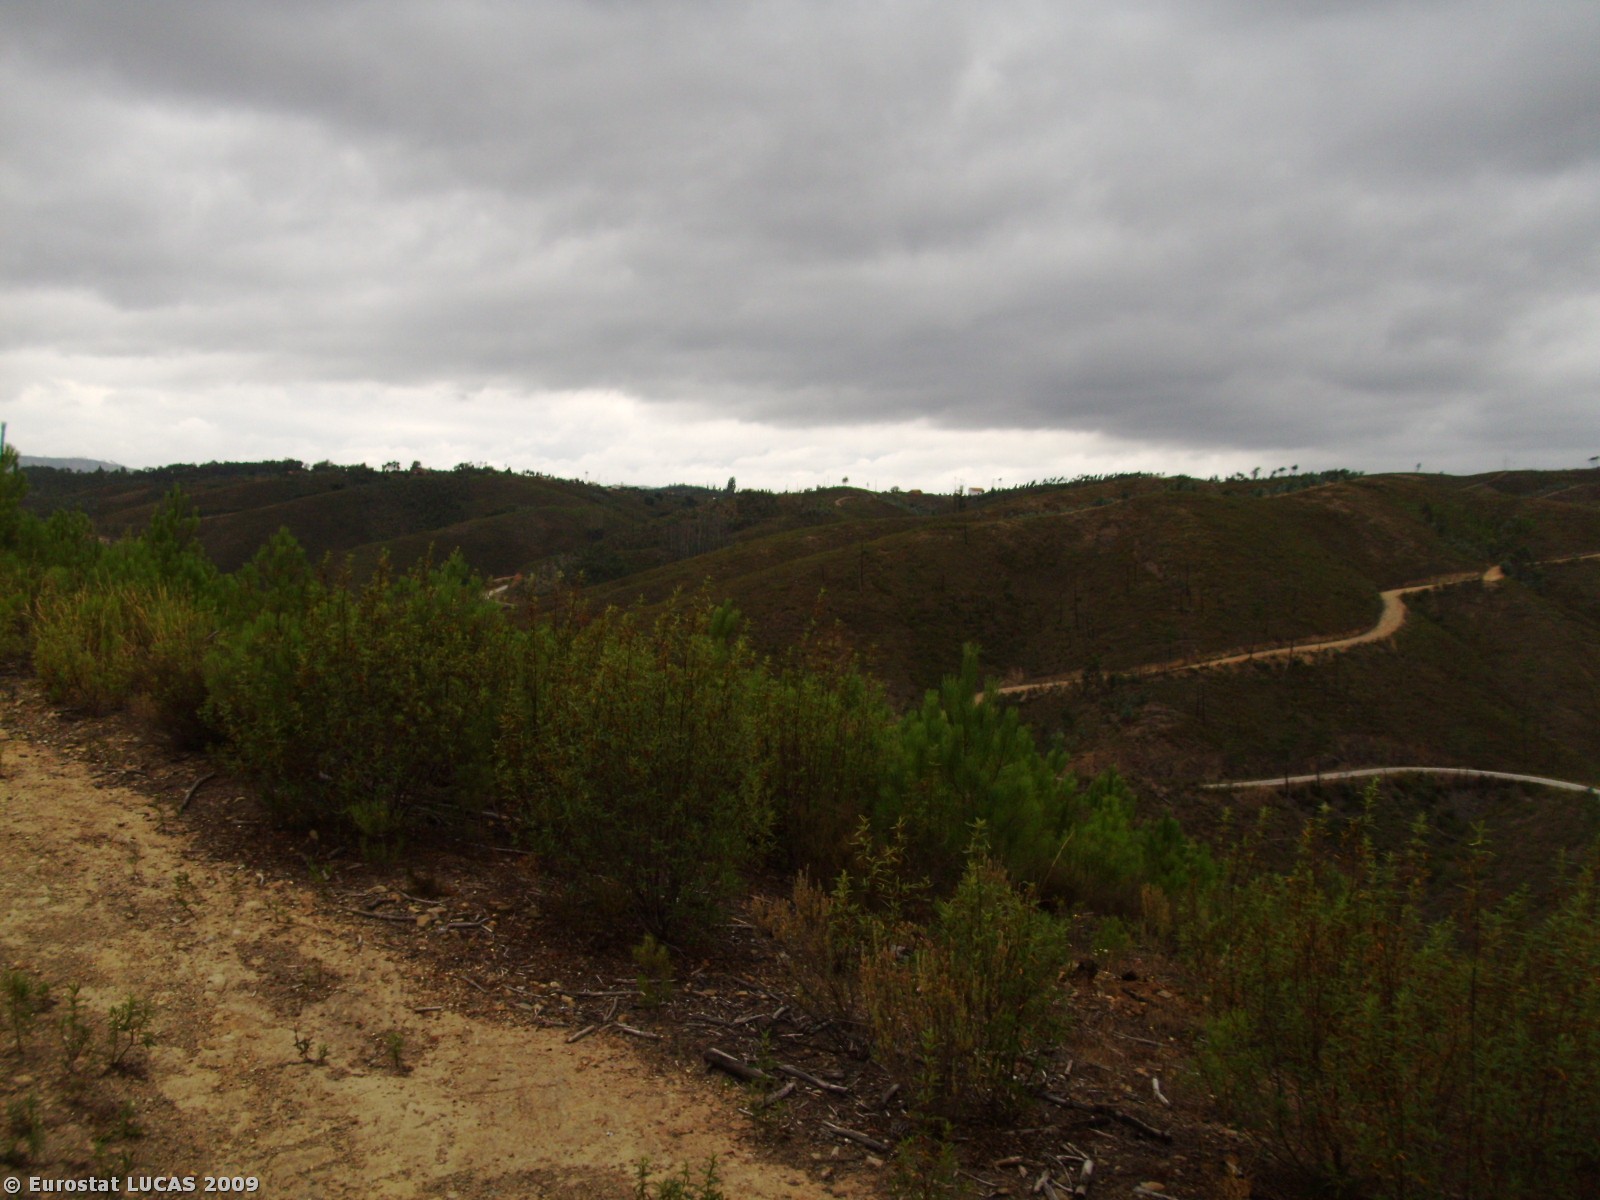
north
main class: Woodland
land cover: Coniferous woodland
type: coniferous forest of the mediterranean region
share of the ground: > 75 %
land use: Forestry
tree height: > 5 m
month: July
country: PT
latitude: 39.7560
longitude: -8.1714
